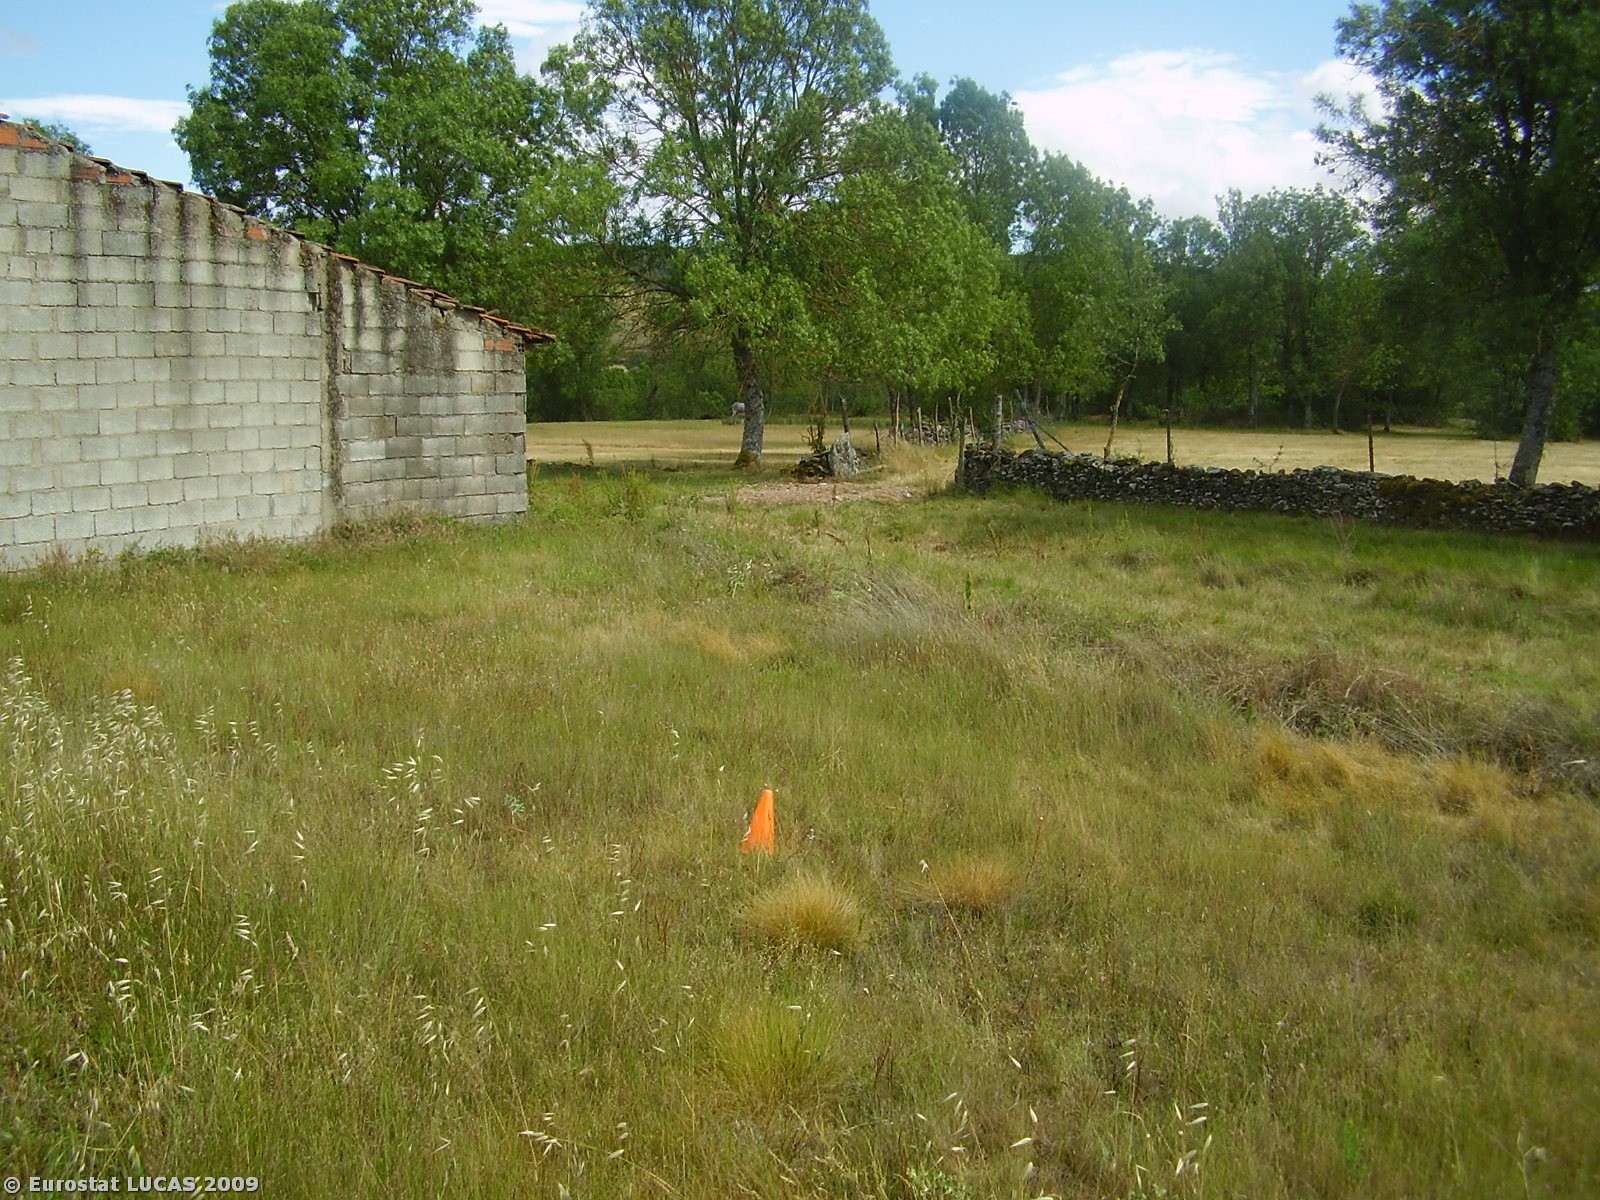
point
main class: Cropland
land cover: Temporary grasslands
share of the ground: > 75 %
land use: Agriculture (excluding fallow land and kitchen gardens)
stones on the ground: 10 - 25 %
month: June
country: PT
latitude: 41.5245
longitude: -6.8530
